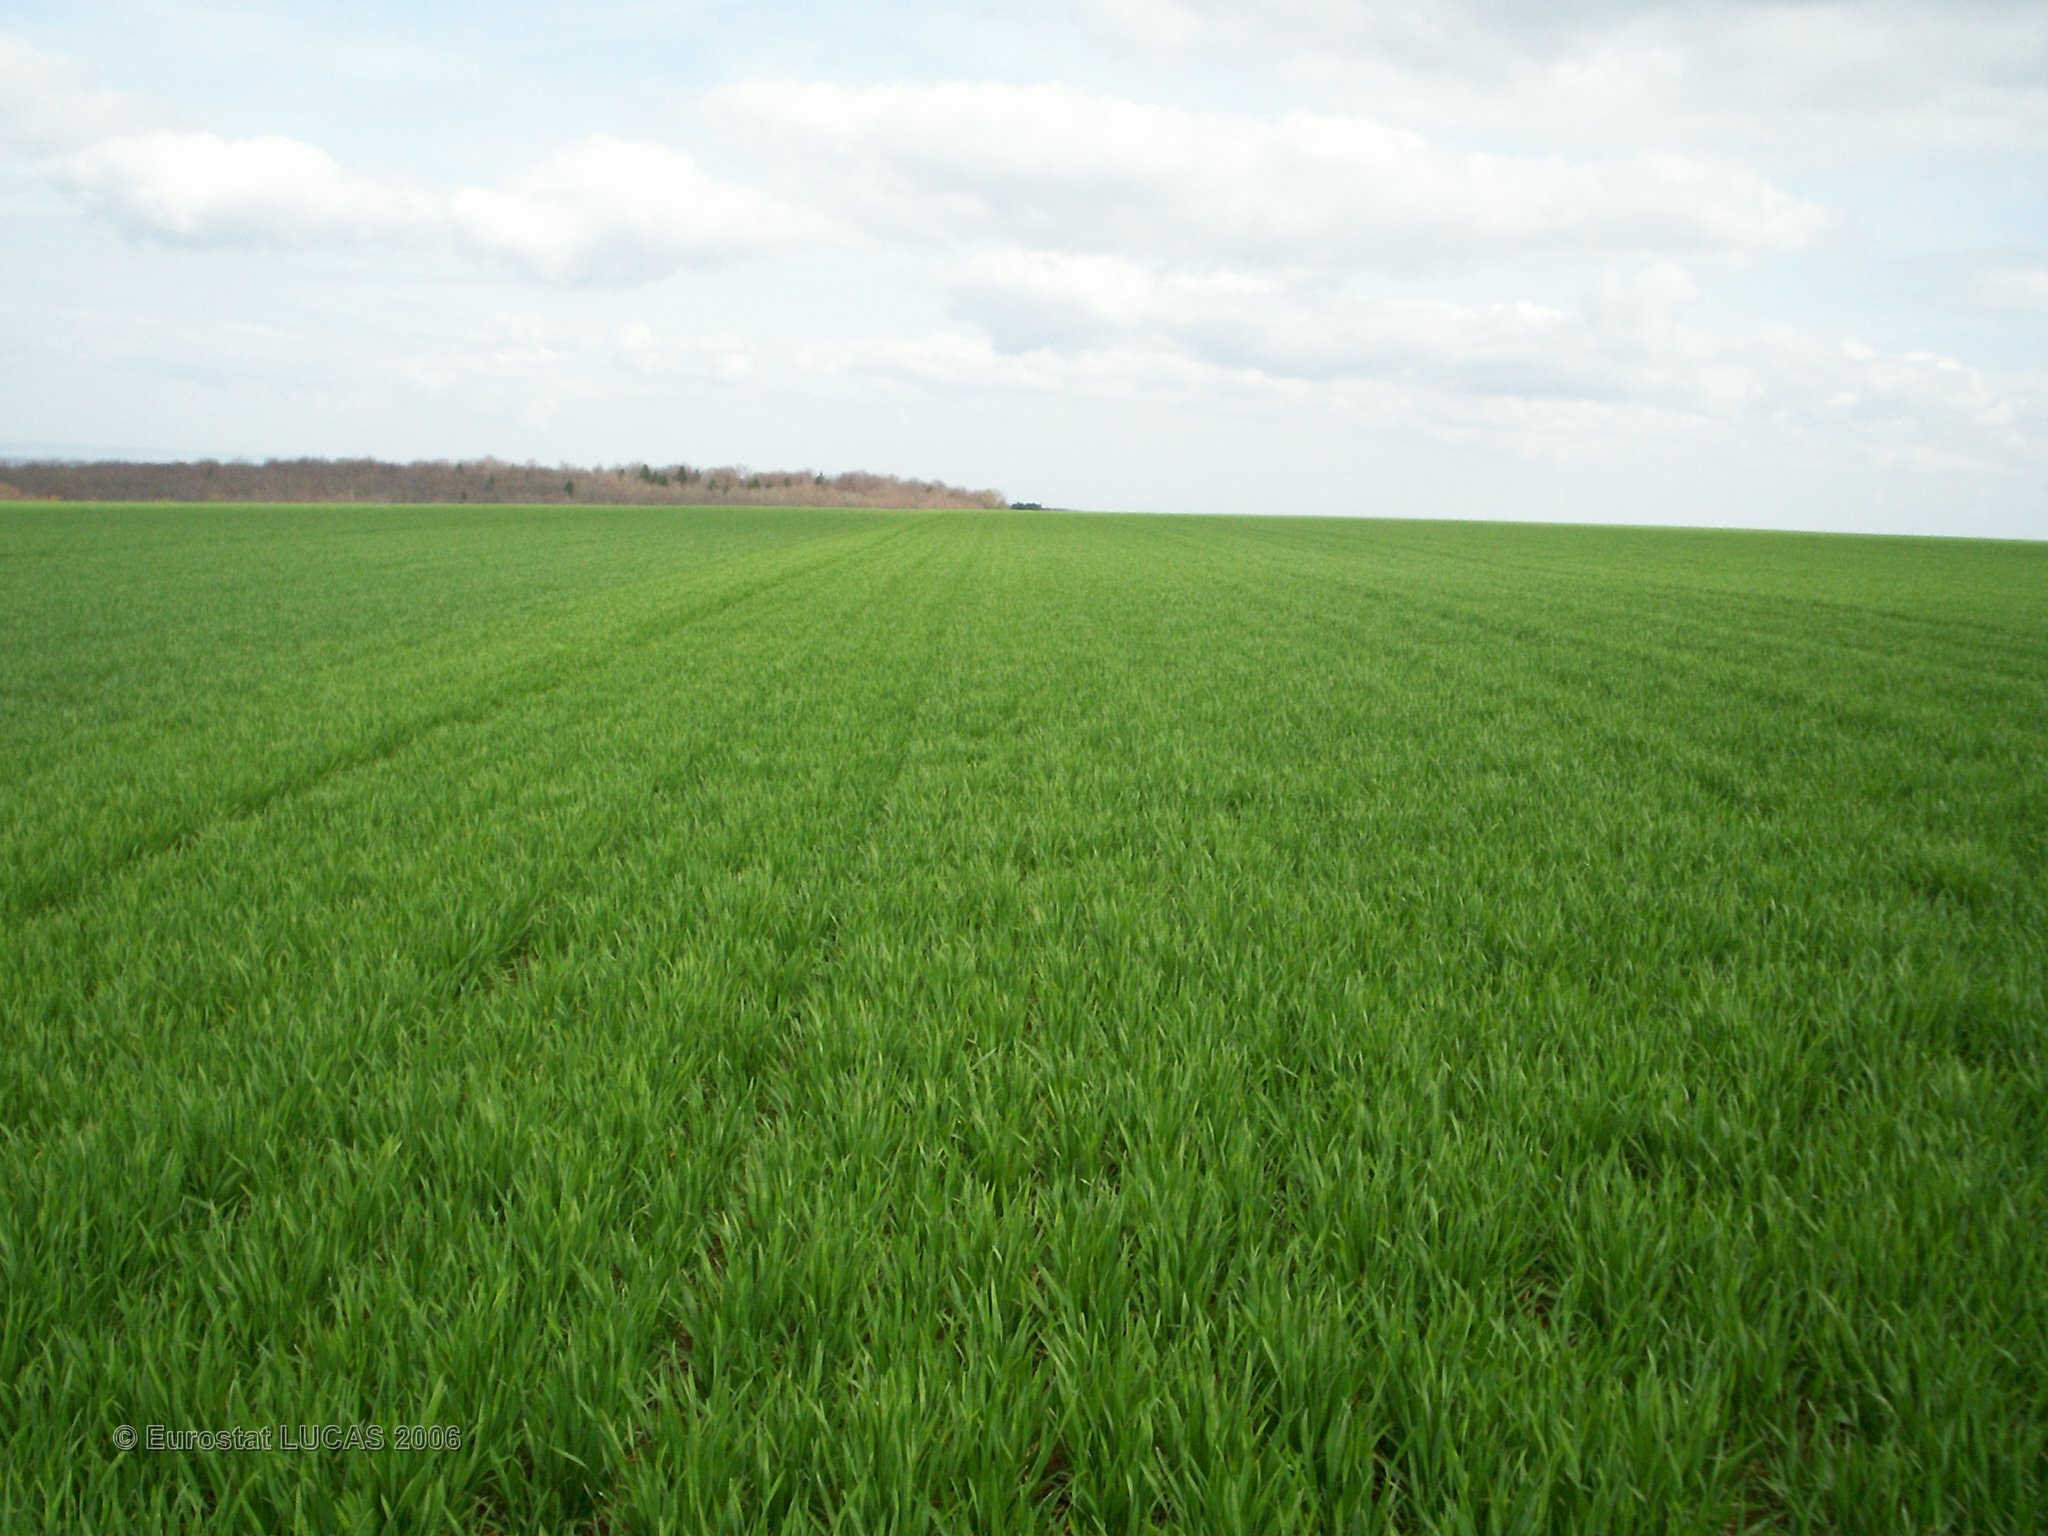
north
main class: Cropland
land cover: Common wheat
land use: Agriculture (excluding fallow land and kitchen gardens)
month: April
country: FR
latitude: 47.9181
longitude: 4.0422
